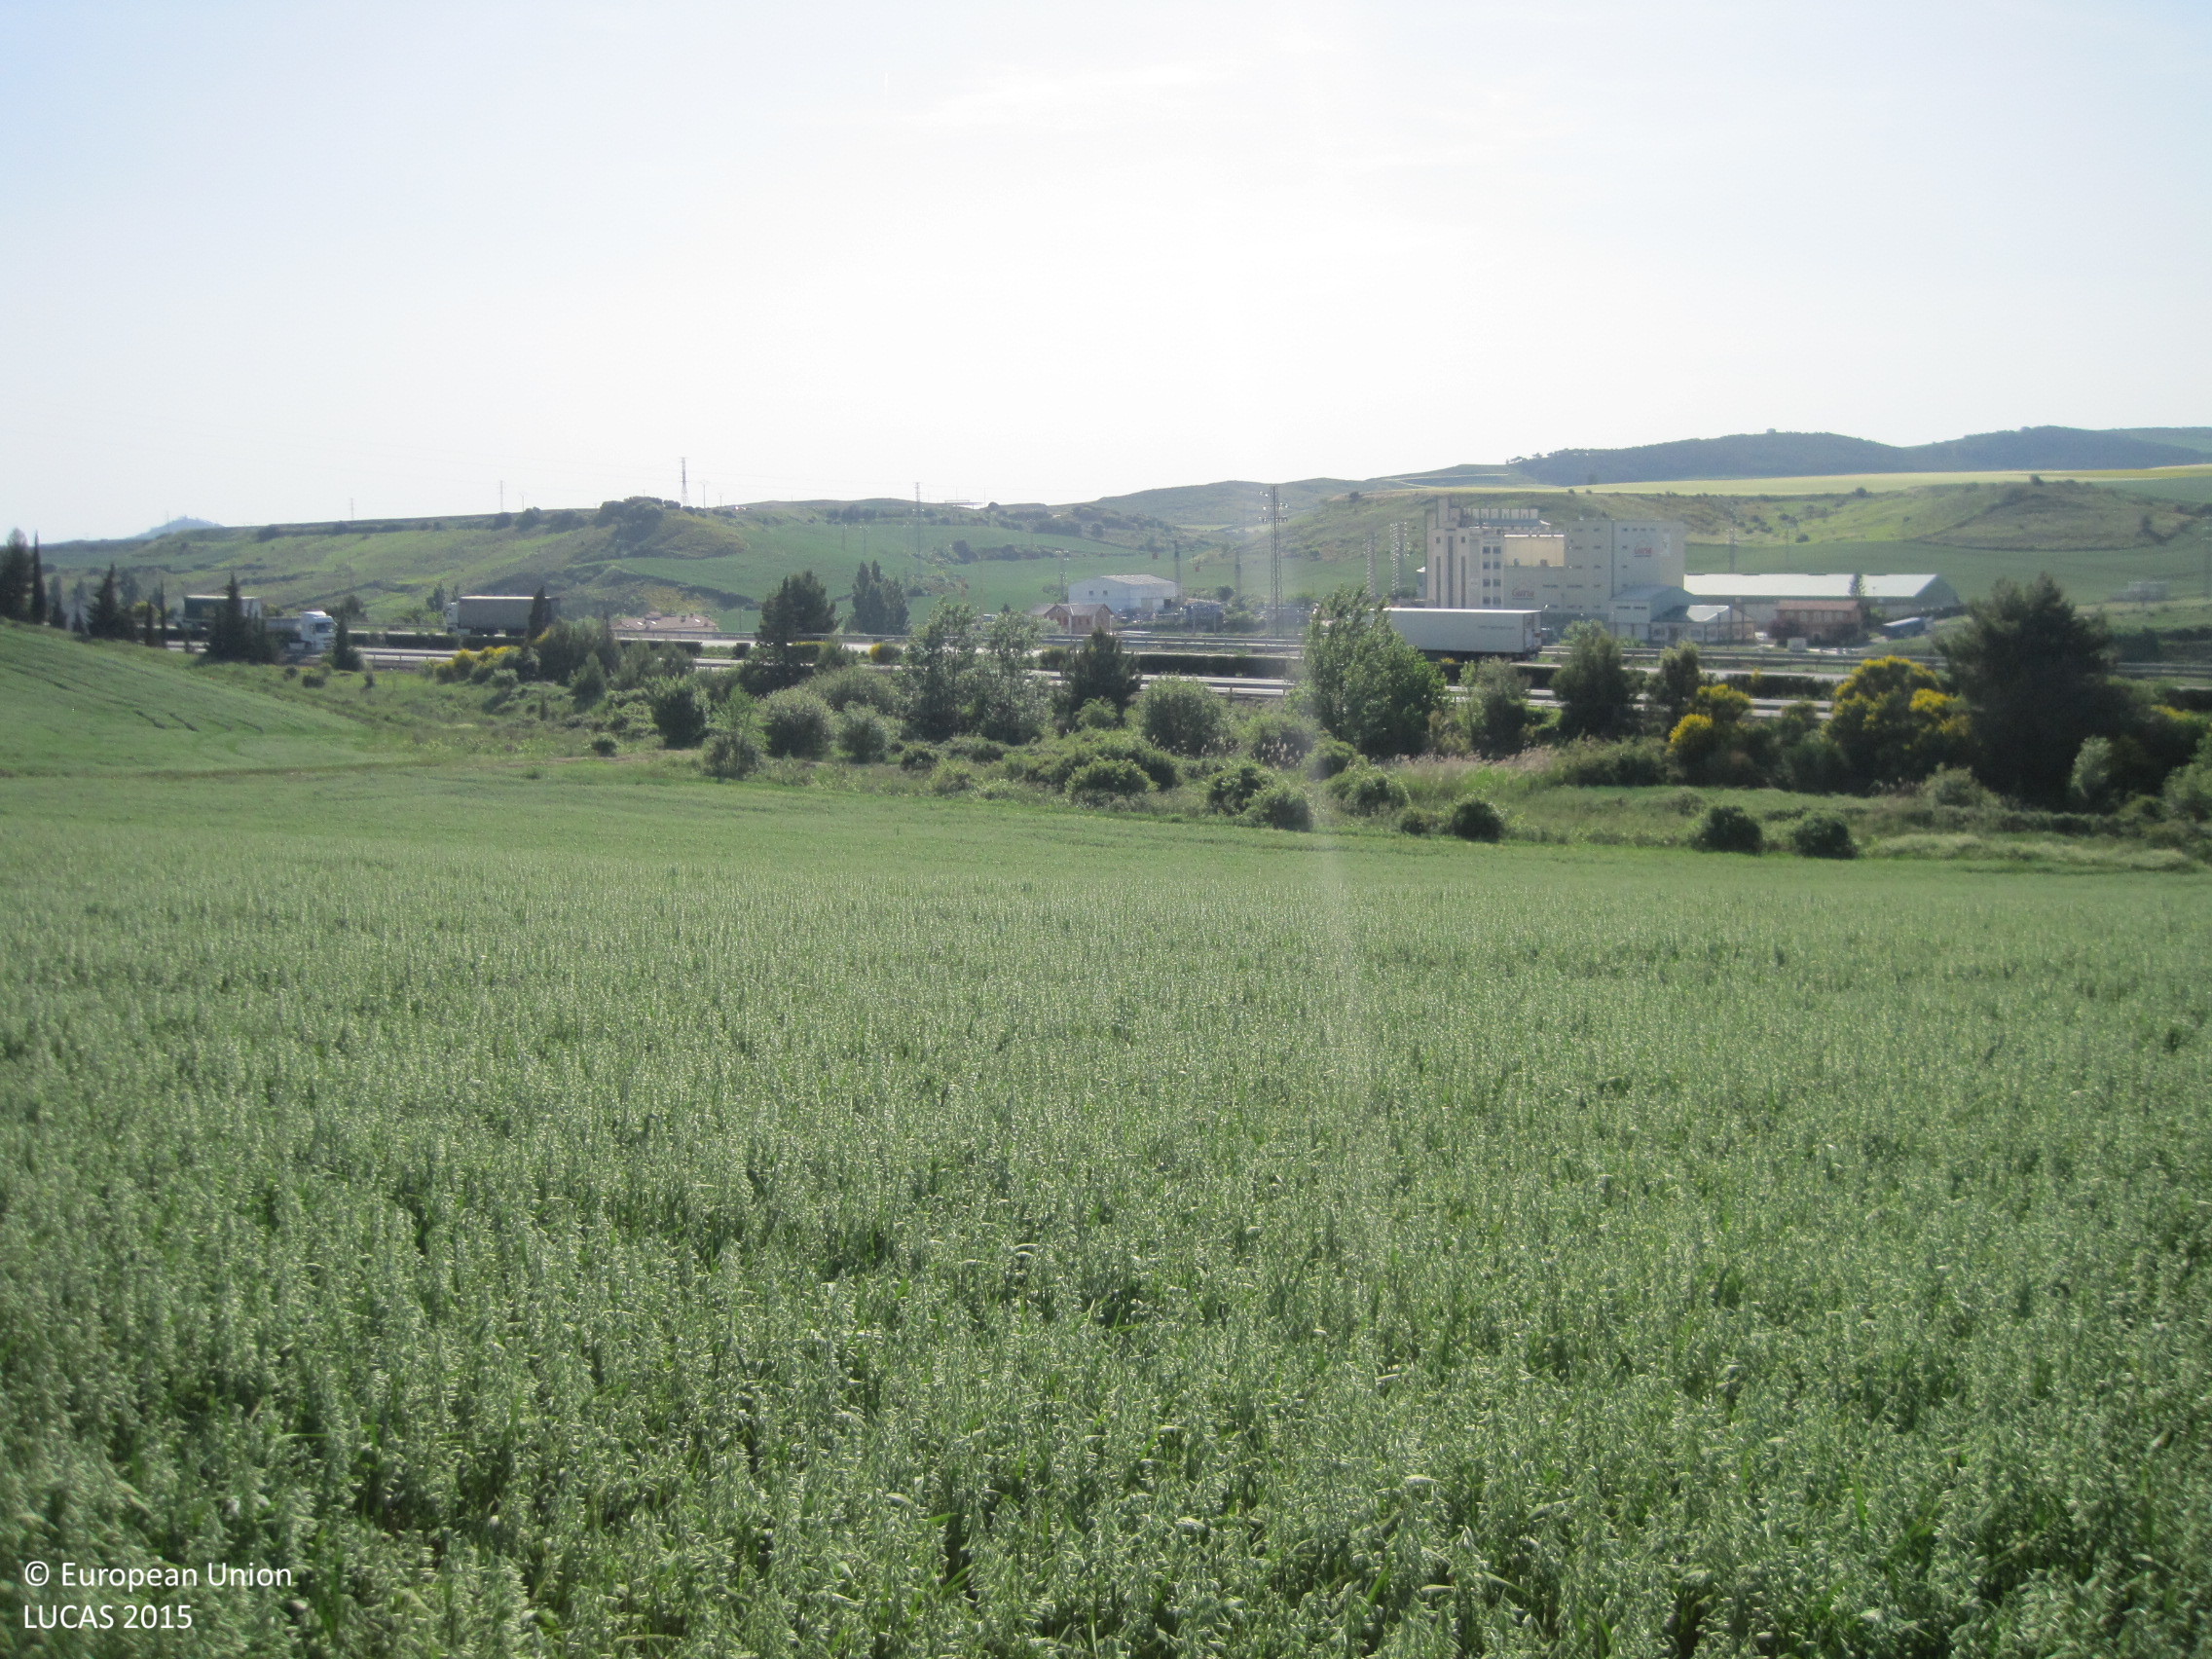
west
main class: Cropland
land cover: Oats
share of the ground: > 75 %
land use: Agriculture (excluding fallow land and kitchen gardens)
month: May
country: ES
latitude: 42.6906
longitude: -1.6456
